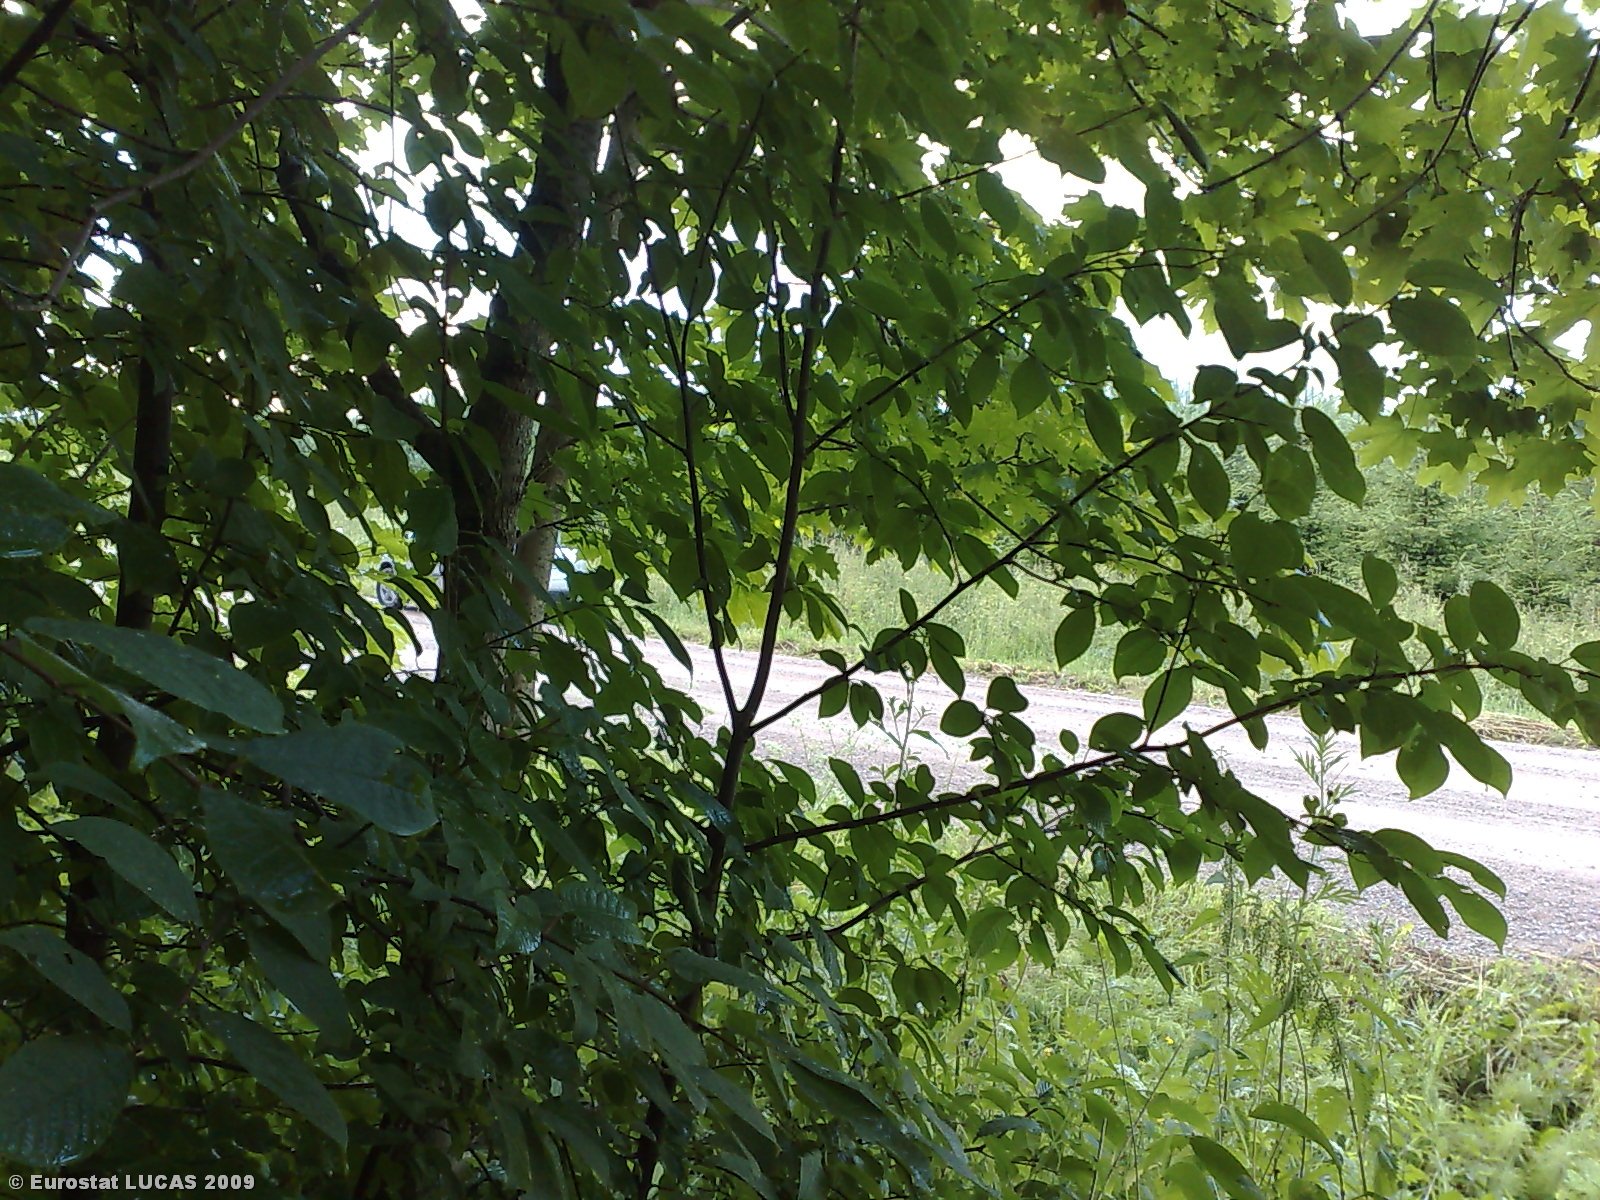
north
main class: Woodland
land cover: Broadleaved woodland
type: non-riverine alder, birch or aspen forest
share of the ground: > 75 %
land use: Forestry
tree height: > 5 m
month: July
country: LT
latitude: 55.6563
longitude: 22.7641
